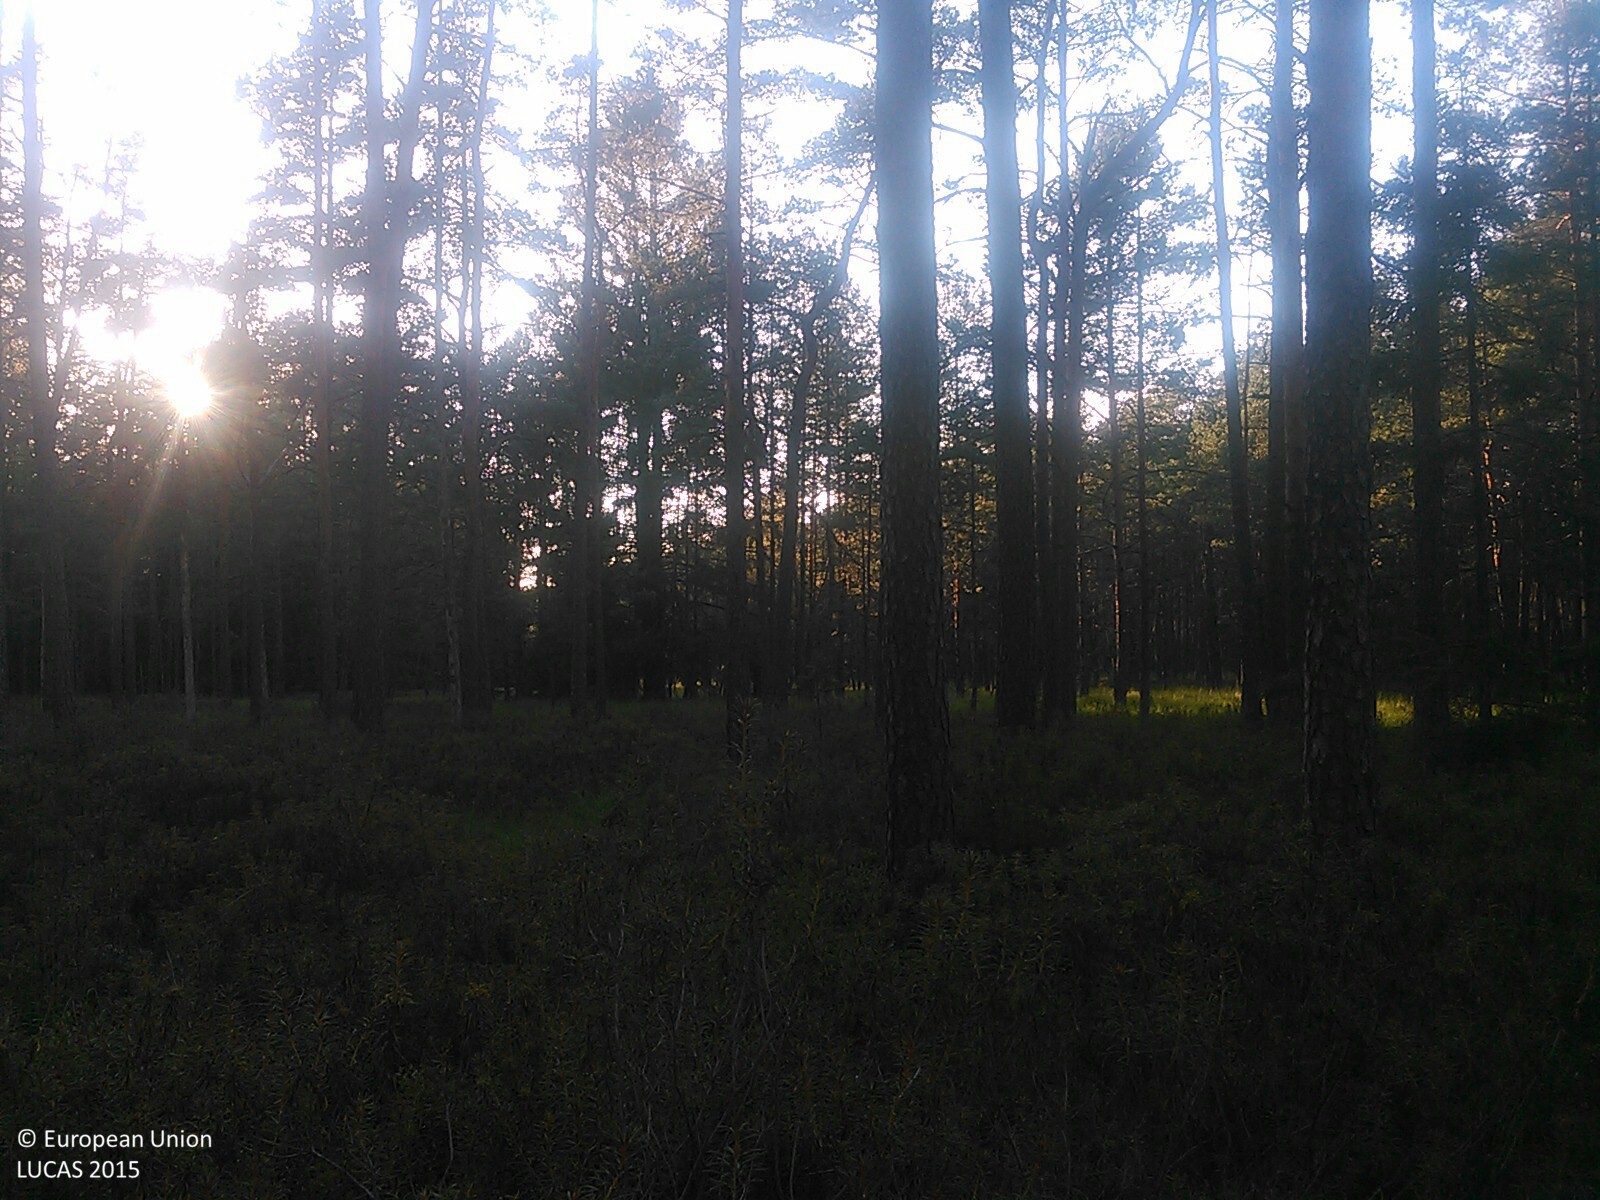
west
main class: Woodland
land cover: Pine dominated coniferous woodland
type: hemiboreal forest and nemoral coniferous forest and mixed broadleaved-coniferous forest
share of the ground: 50 - 75 %
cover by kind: coniferous forest trees 65 %, shrubs 30 %, herbaceous plants 5 %
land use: Forestry
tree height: > 5 m
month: August
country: PL
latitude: 53.9089
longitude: 17.2099
